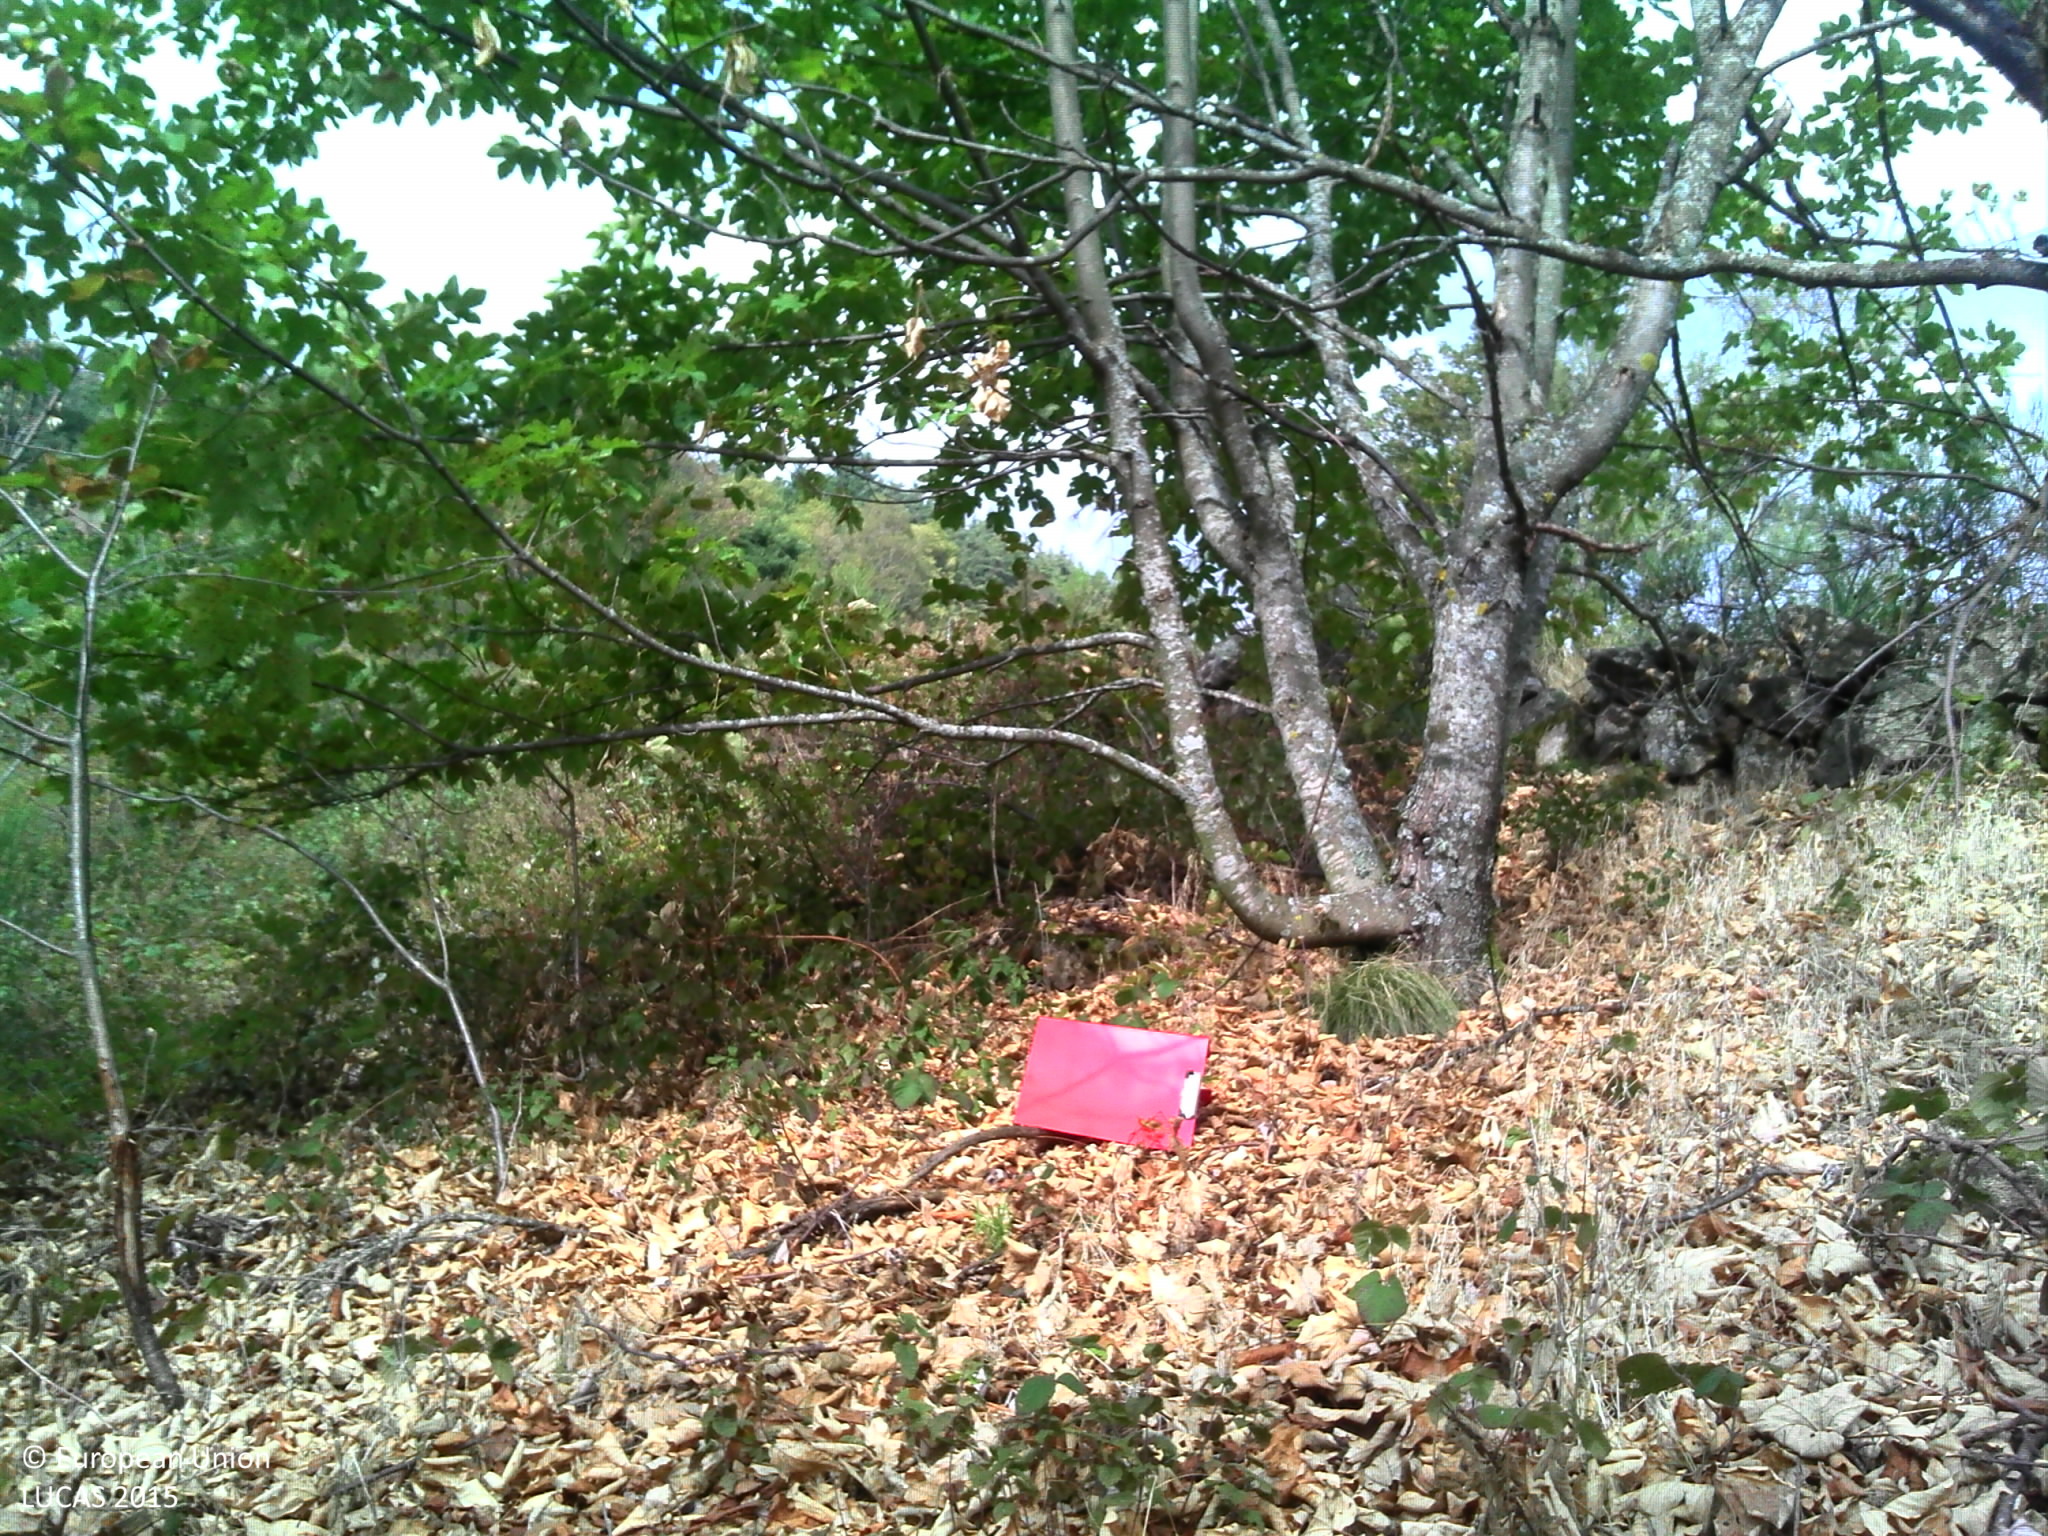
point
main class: Woodland
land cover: Broadleaved woodland
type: mesophytic deciduous forest
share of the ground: > 75 %
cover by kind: broadleaved forest trees 90 %, herbaceous plants 10 %
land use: Agriculture (excluding fallow land and kitchen gardens)
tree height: > 5 m
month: September
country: FR
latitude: 45.2906
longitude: 4.5345
